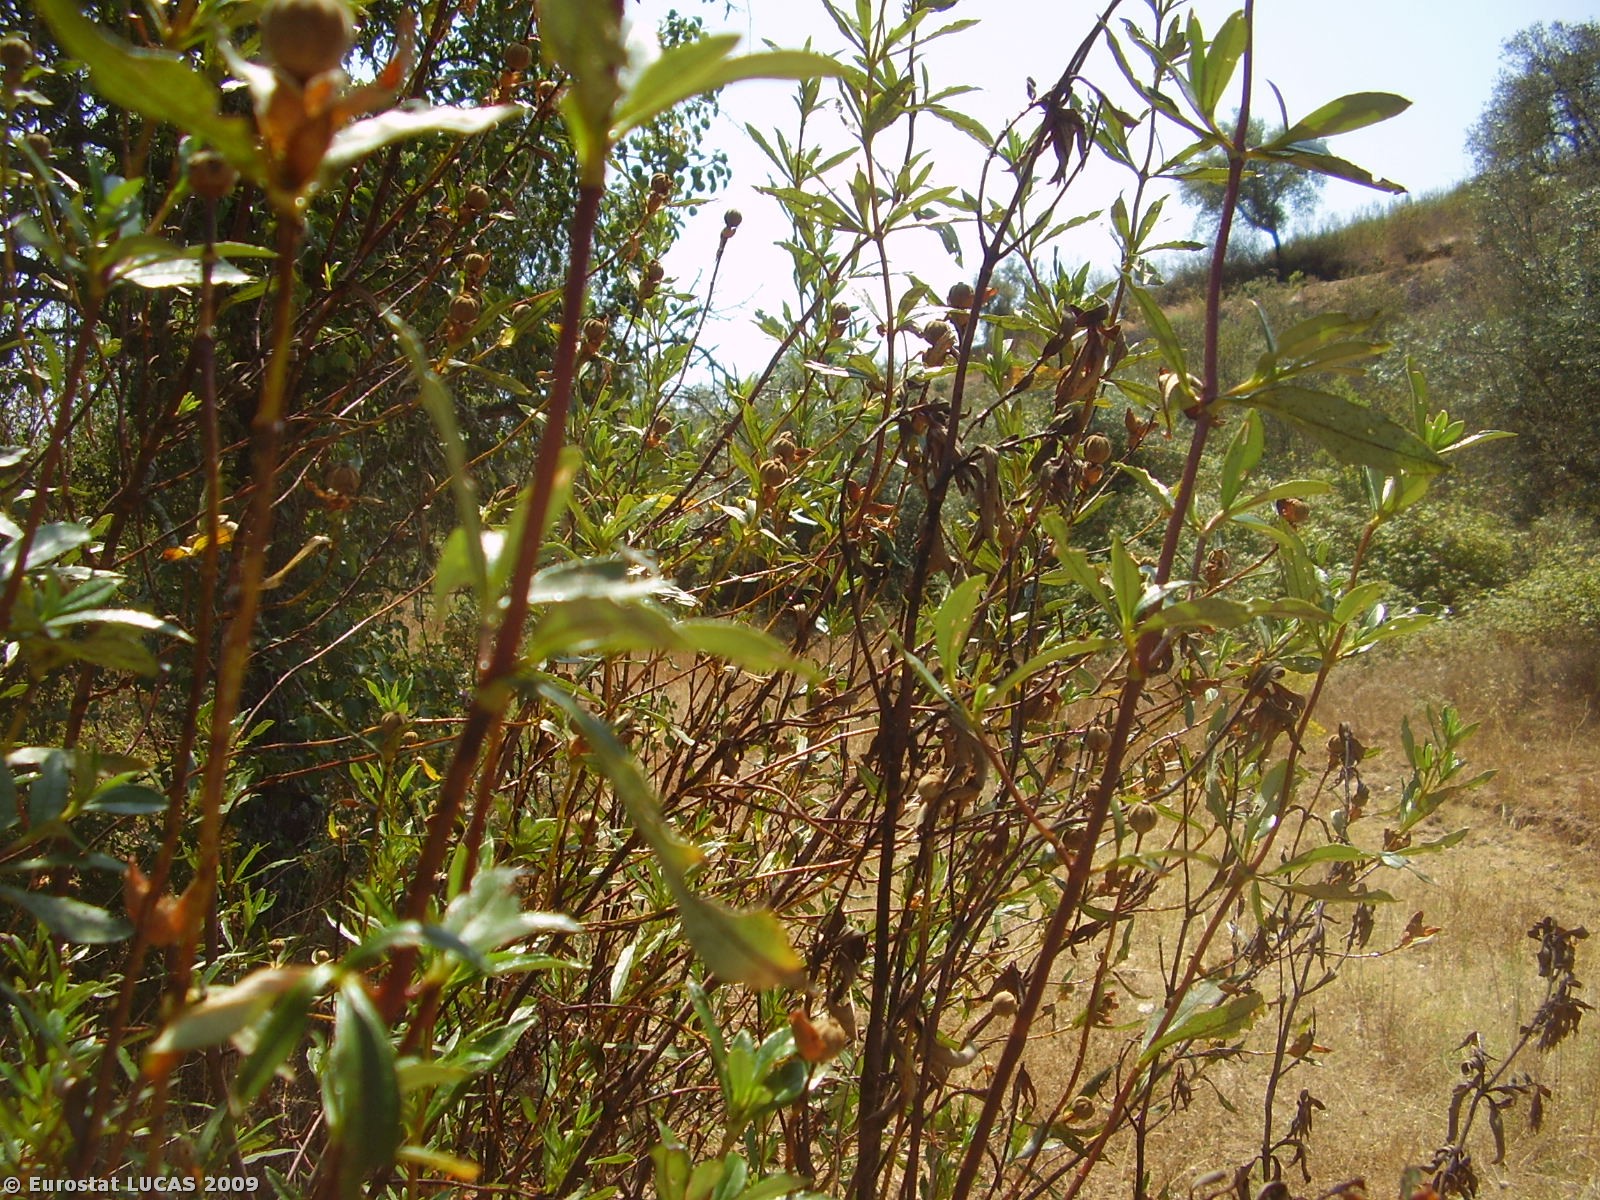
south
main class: Shrubland
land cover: Shrubland with sparse tree cover
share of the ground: > 75 %
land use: Fallow land
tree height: > 5 m
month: August
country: PT
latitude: 37.6305
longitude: -8.3543
